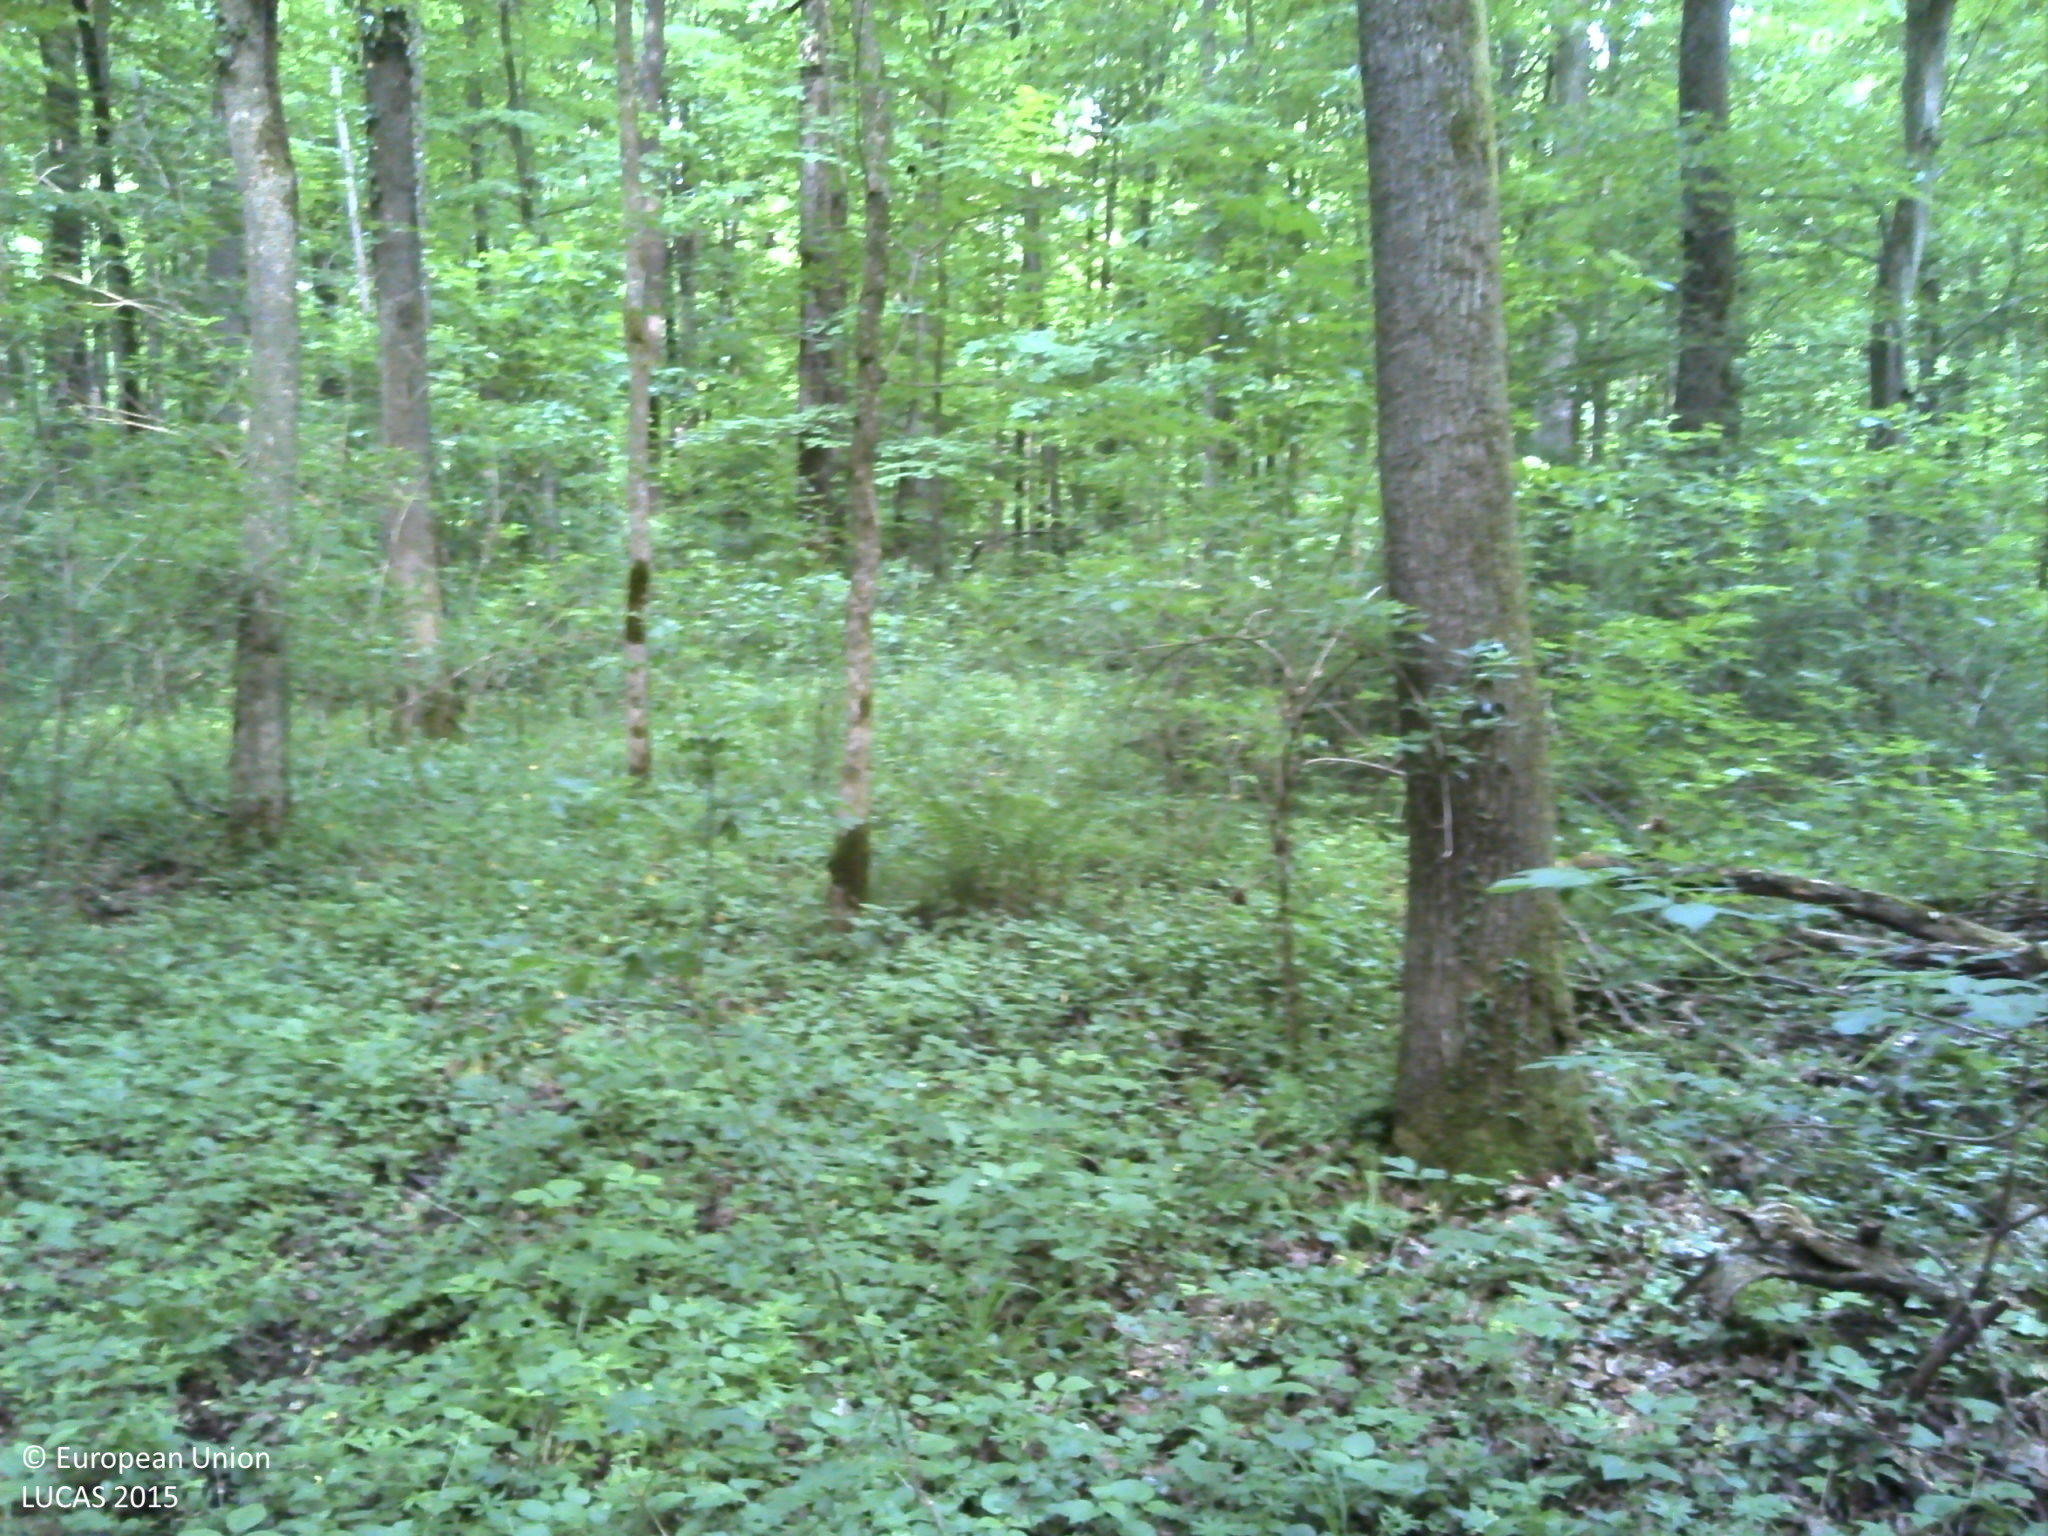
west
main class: Woodland
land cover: Broadleaved woodland
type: acidophilous oak and oak-birch forest
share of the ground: > 75 %
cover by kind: broadleaved forest trees 100 %
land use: Forestry
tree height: > 5 m
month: May
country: HR
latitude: 45.5818
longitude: 18.2204
